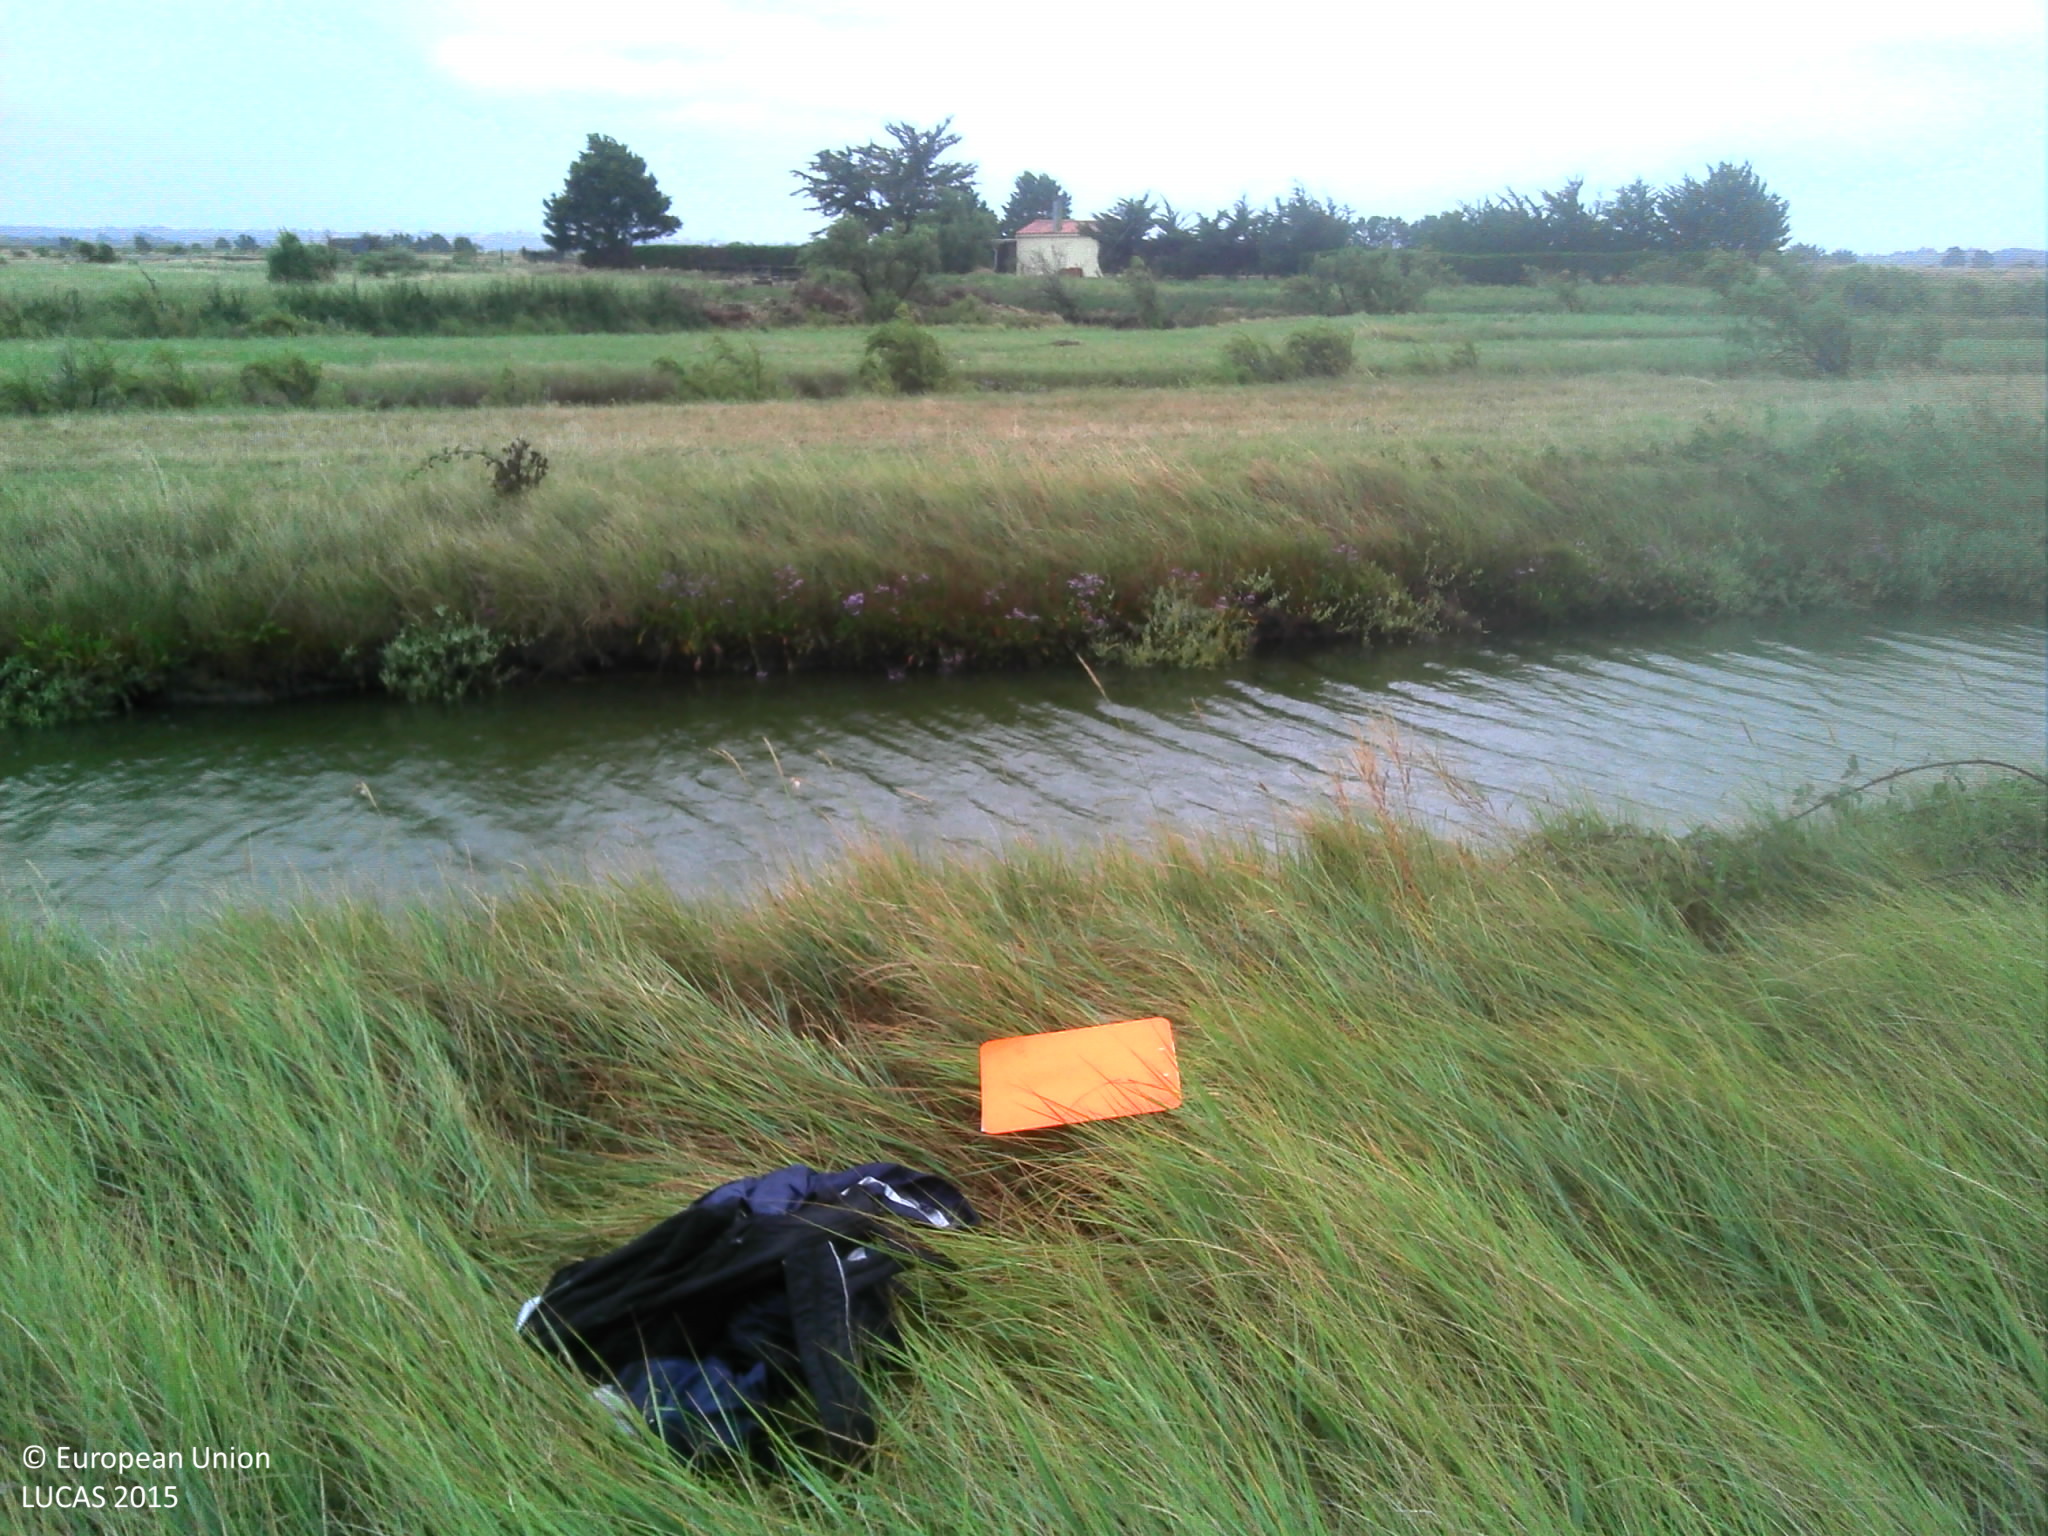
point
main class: Grassland
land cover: Spontaneously vegetated surfaces
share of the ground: > 75 %
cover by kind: herbaceous plants 95 %, shrubs 5 %
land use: Semi-natural and natural areas not in use
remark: Temporary flooded
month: August
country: FR
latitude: 46.5691
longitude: -1.7971
